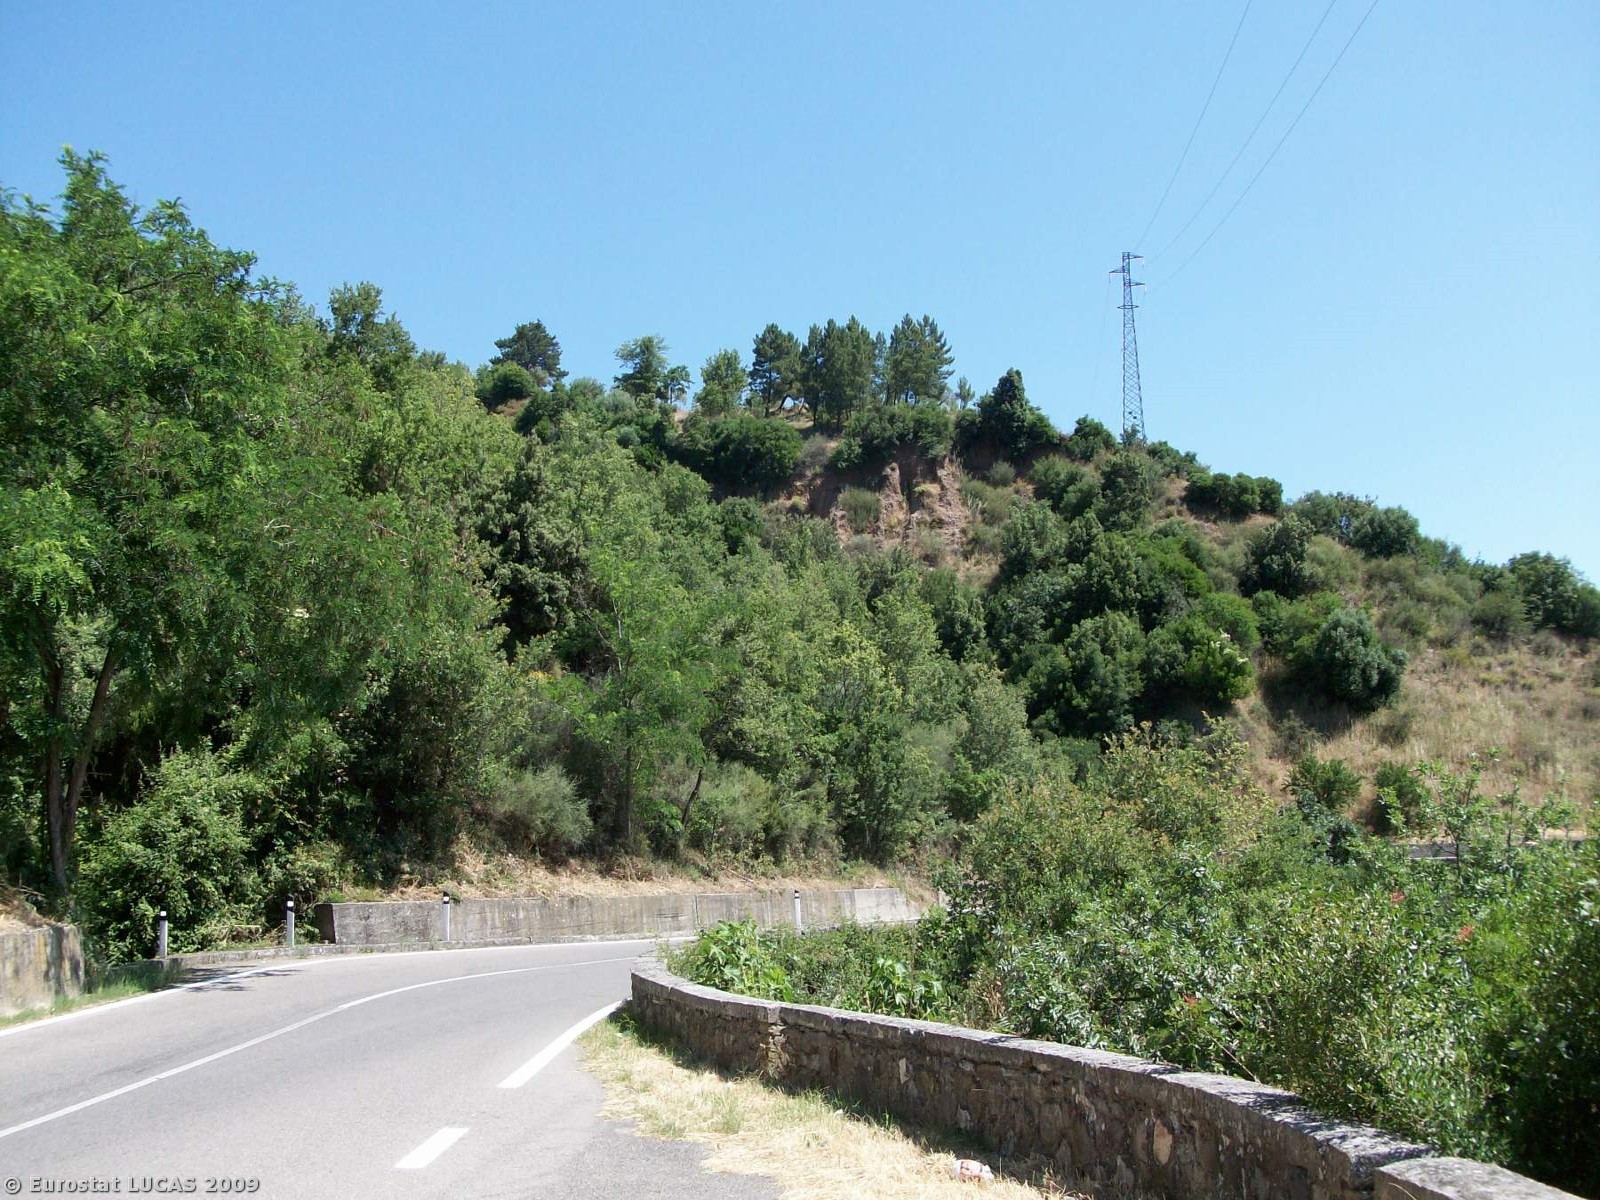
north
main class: Woodland
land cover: Broadleaved woodland
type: thermophilous deciduous forest
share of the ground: > 75 %
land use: Unused
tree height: > 5 m
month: June
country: IT
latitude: 39.4915
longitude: 16.7252
